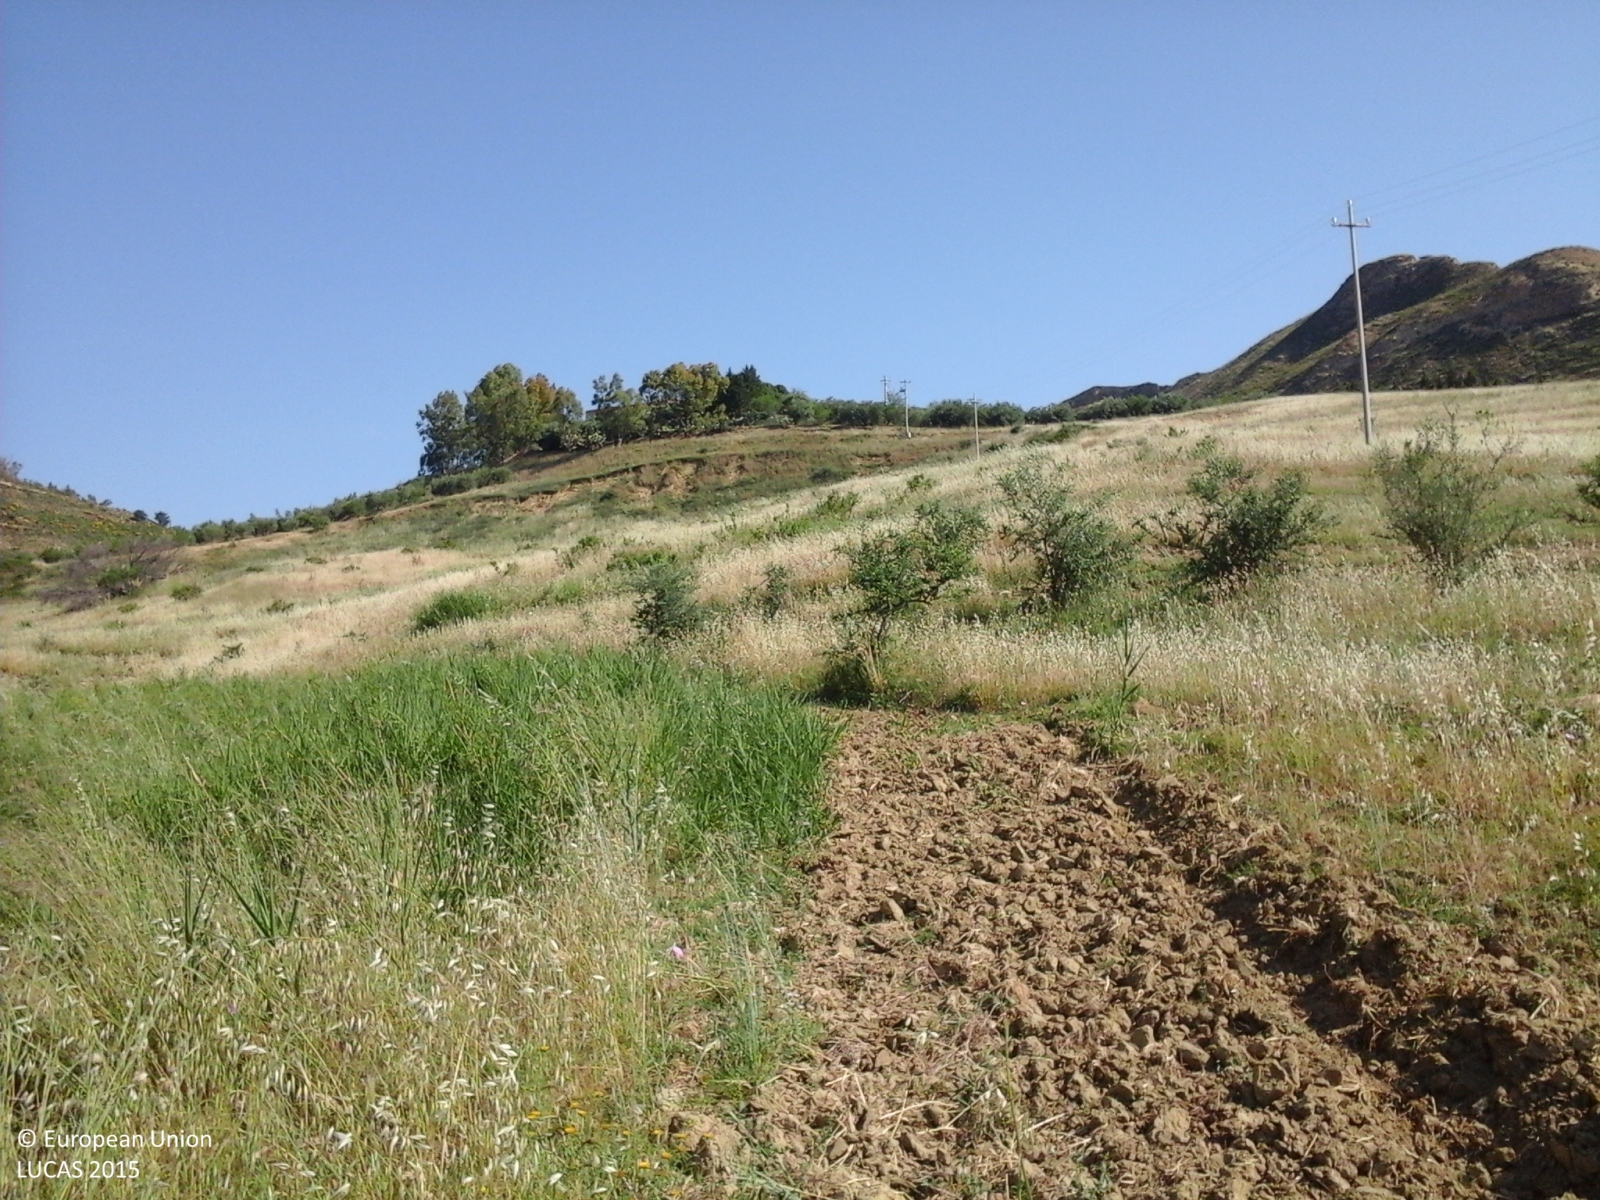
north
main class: Grassland
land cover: Grassland without tree/shrub cover
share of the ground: > 75 %
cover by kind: herbaceous plants 100 %
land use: Agriculture (excluding fallow land and kitchen gardens)
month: June
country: IT
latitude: 37.3888
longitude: 14.4507
